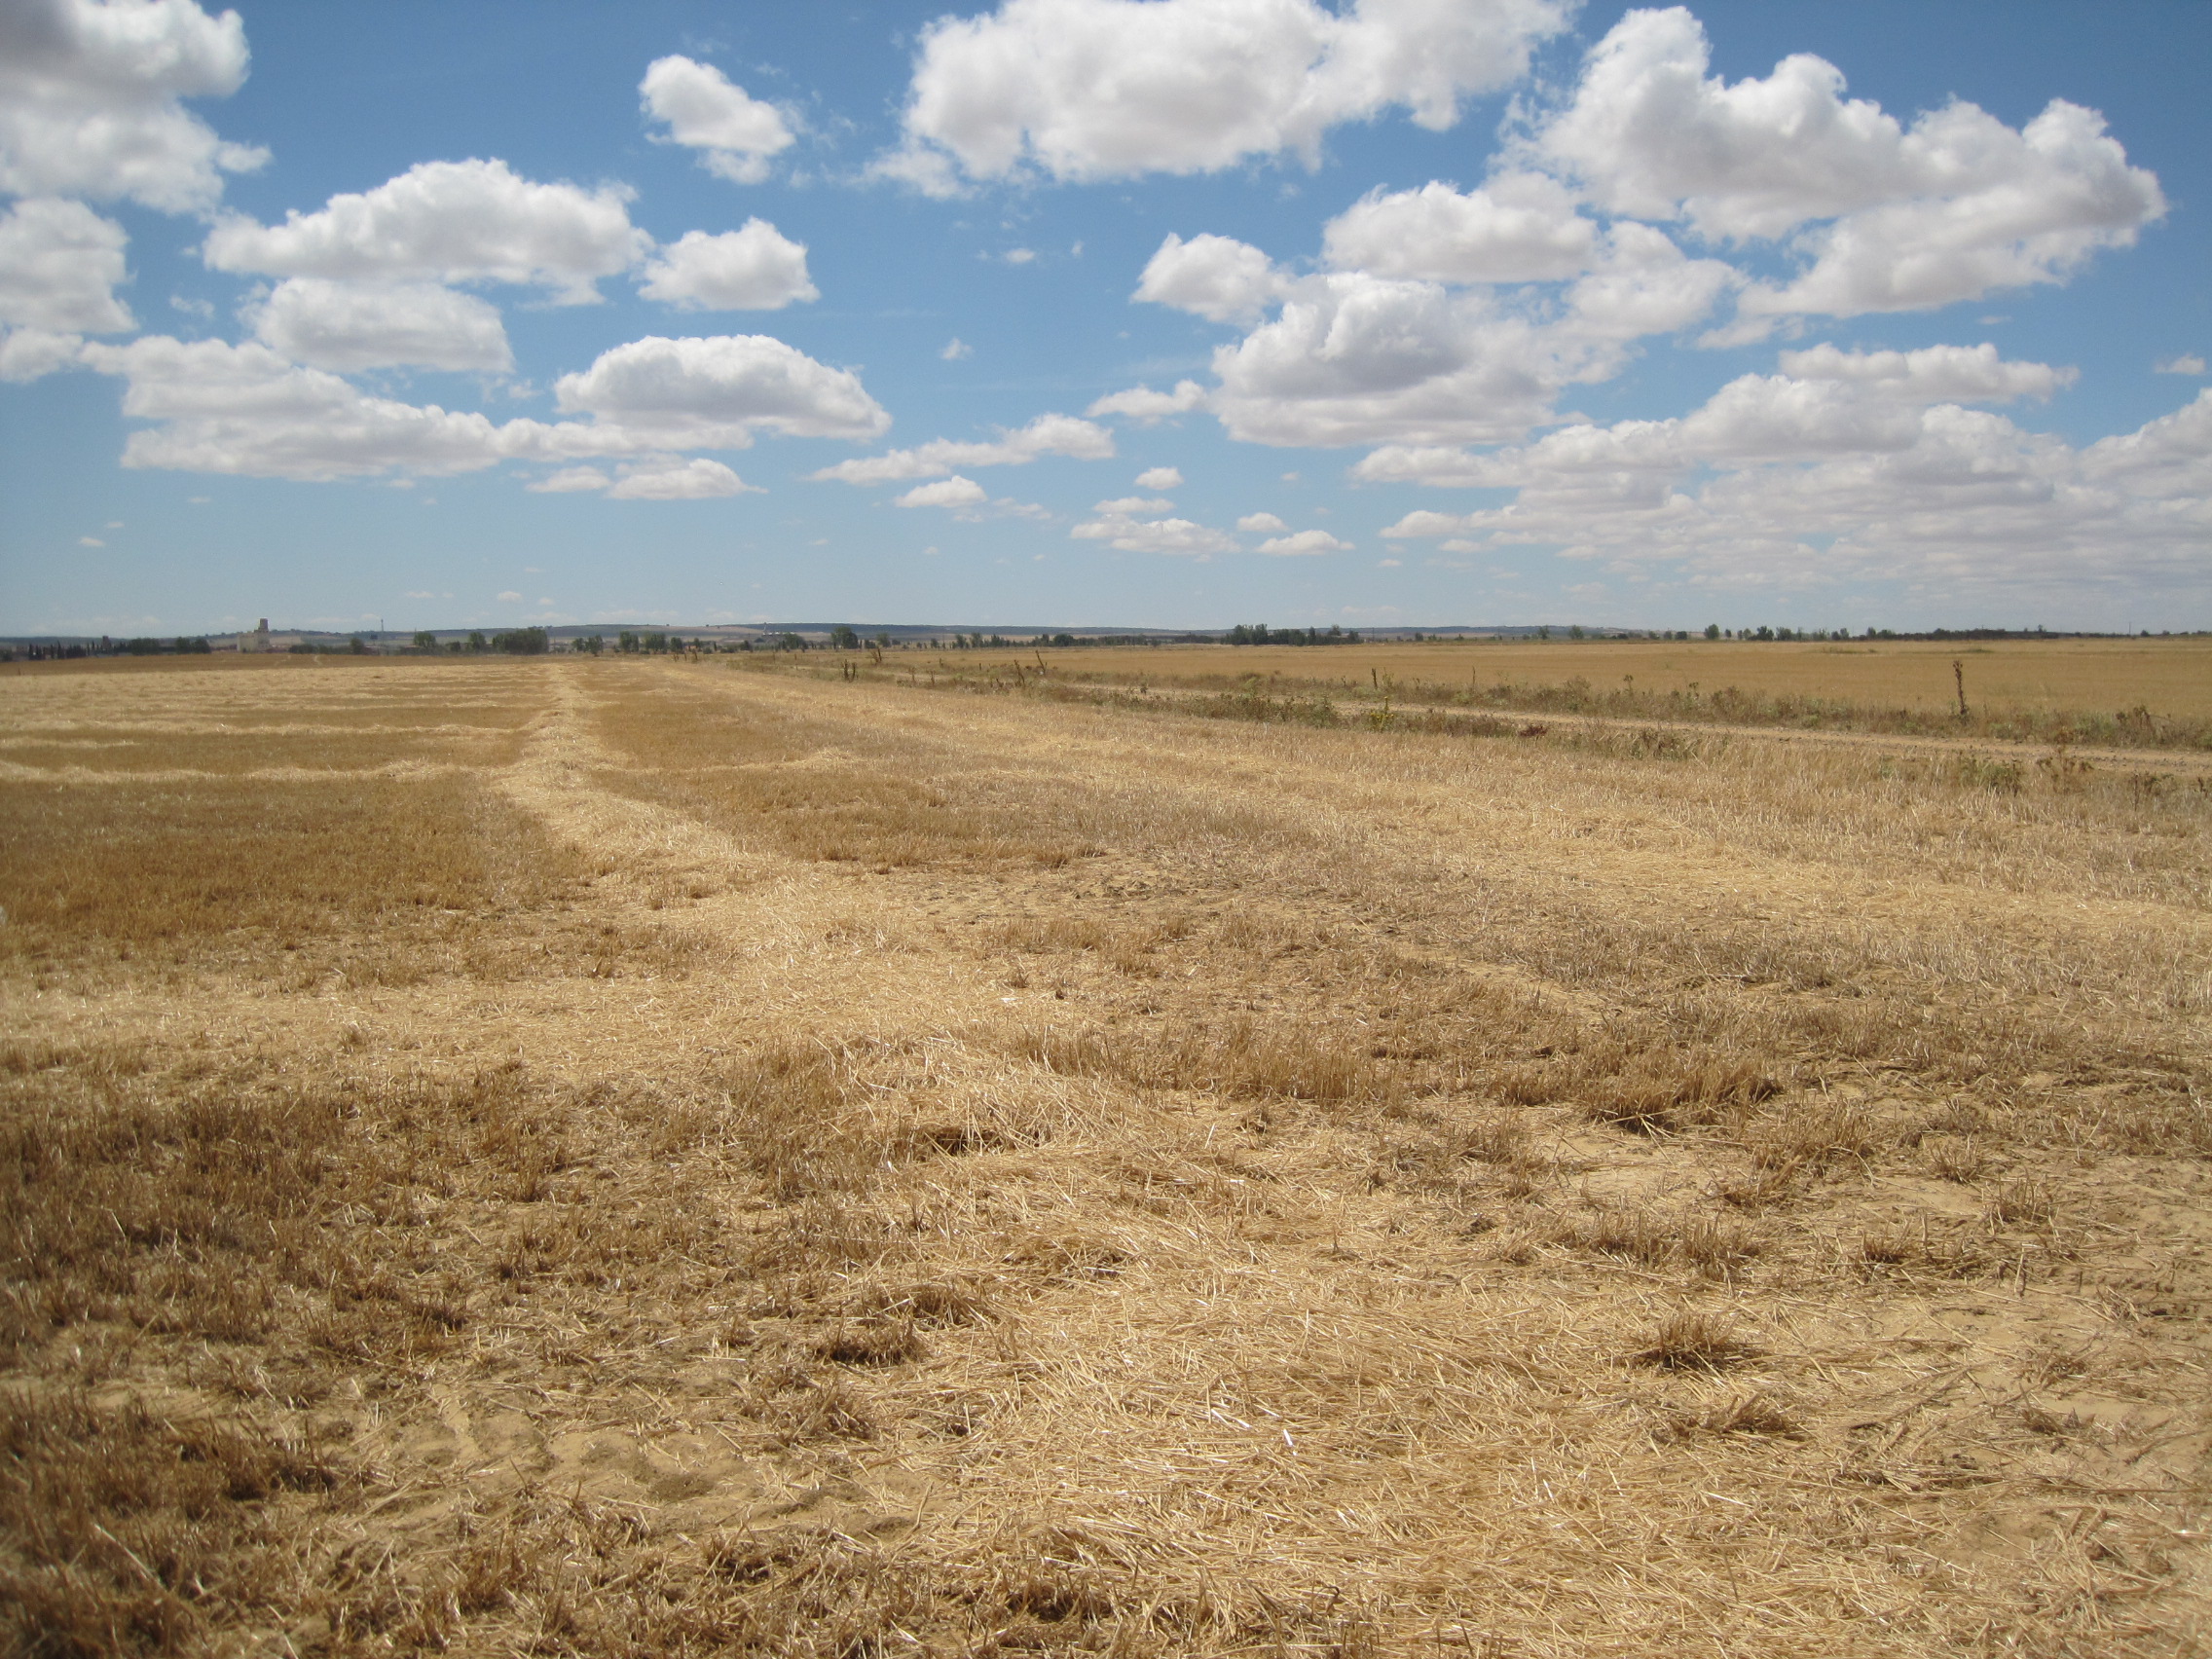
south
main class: Cropland
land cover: Barley
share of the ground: < 10 %
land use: Agriculture (excluding fallow land and kitchen gardens)
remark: Harvested field
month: July
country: ES
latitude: 41.8861
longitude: -5.4265
